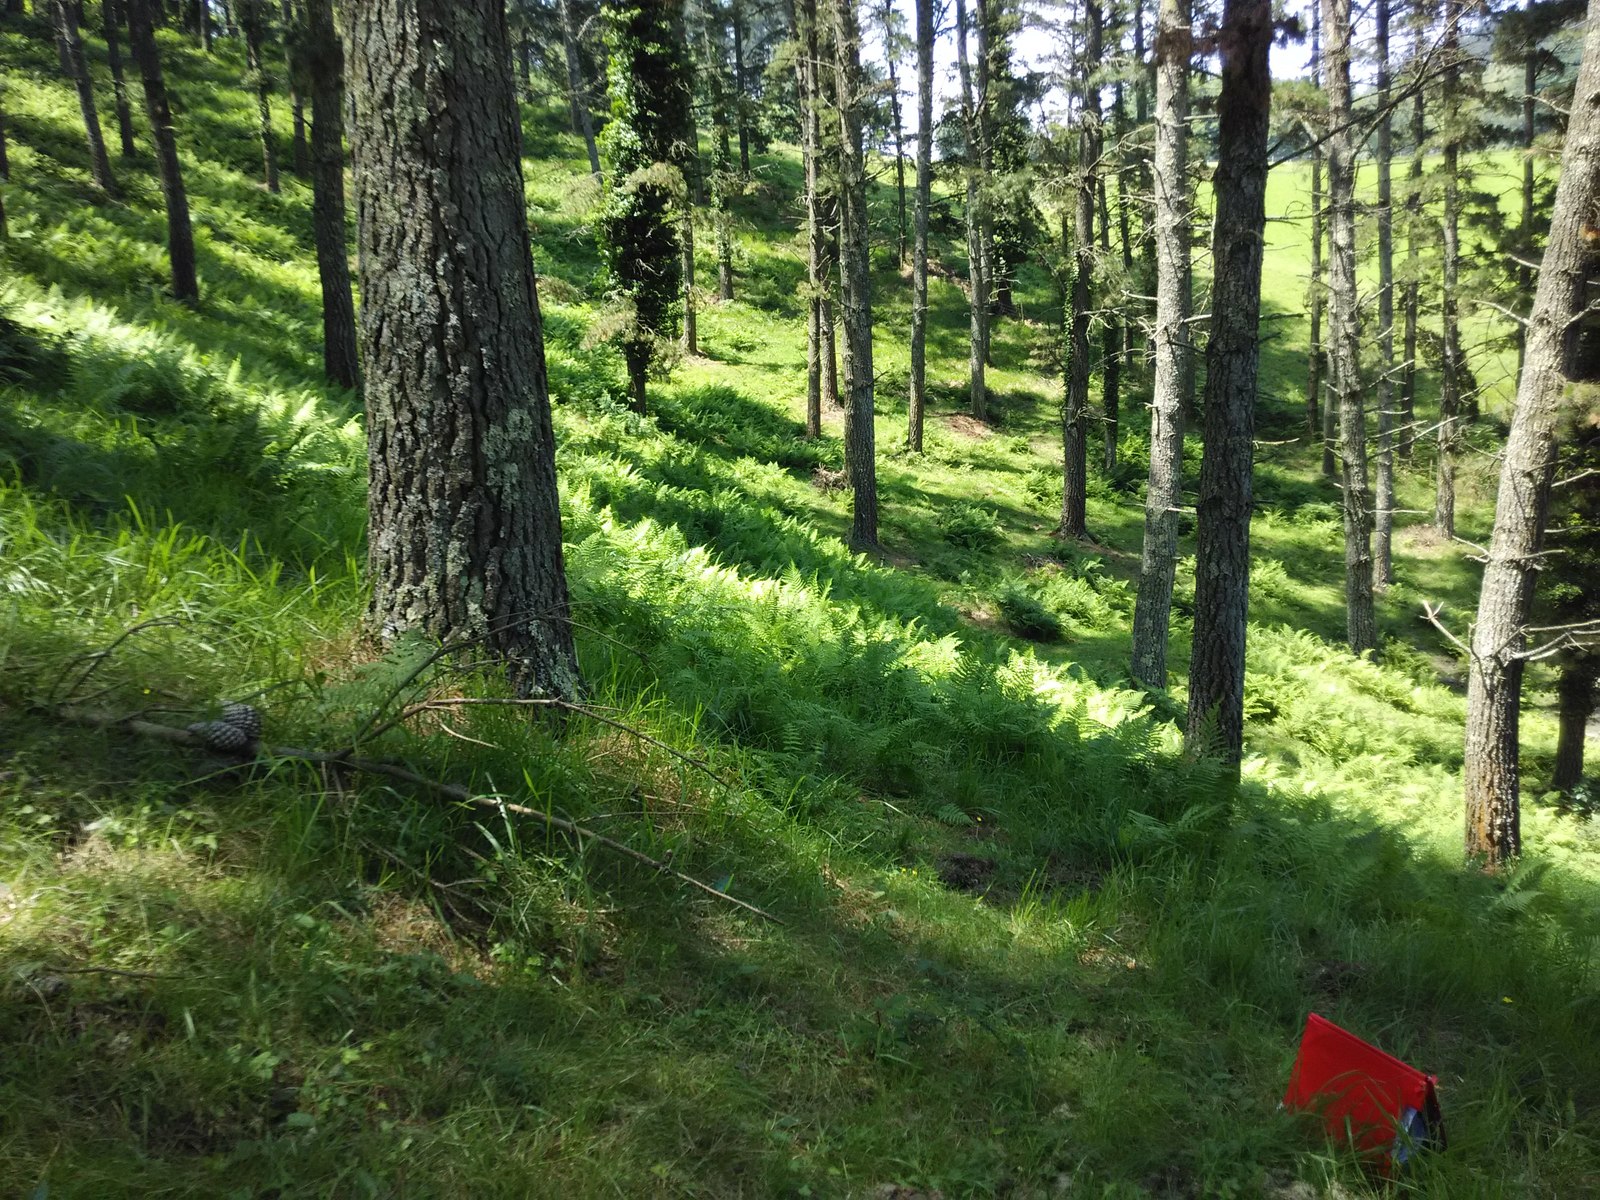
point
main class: Woodland
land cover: Pine dominated coniferous woodland
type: exotic forest
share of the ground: > 75 %
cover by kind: coniferous forest trees 100 %
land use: Forestry
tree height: > 5 m
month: June
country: ES
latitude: 43.2354
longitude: -2.5769
